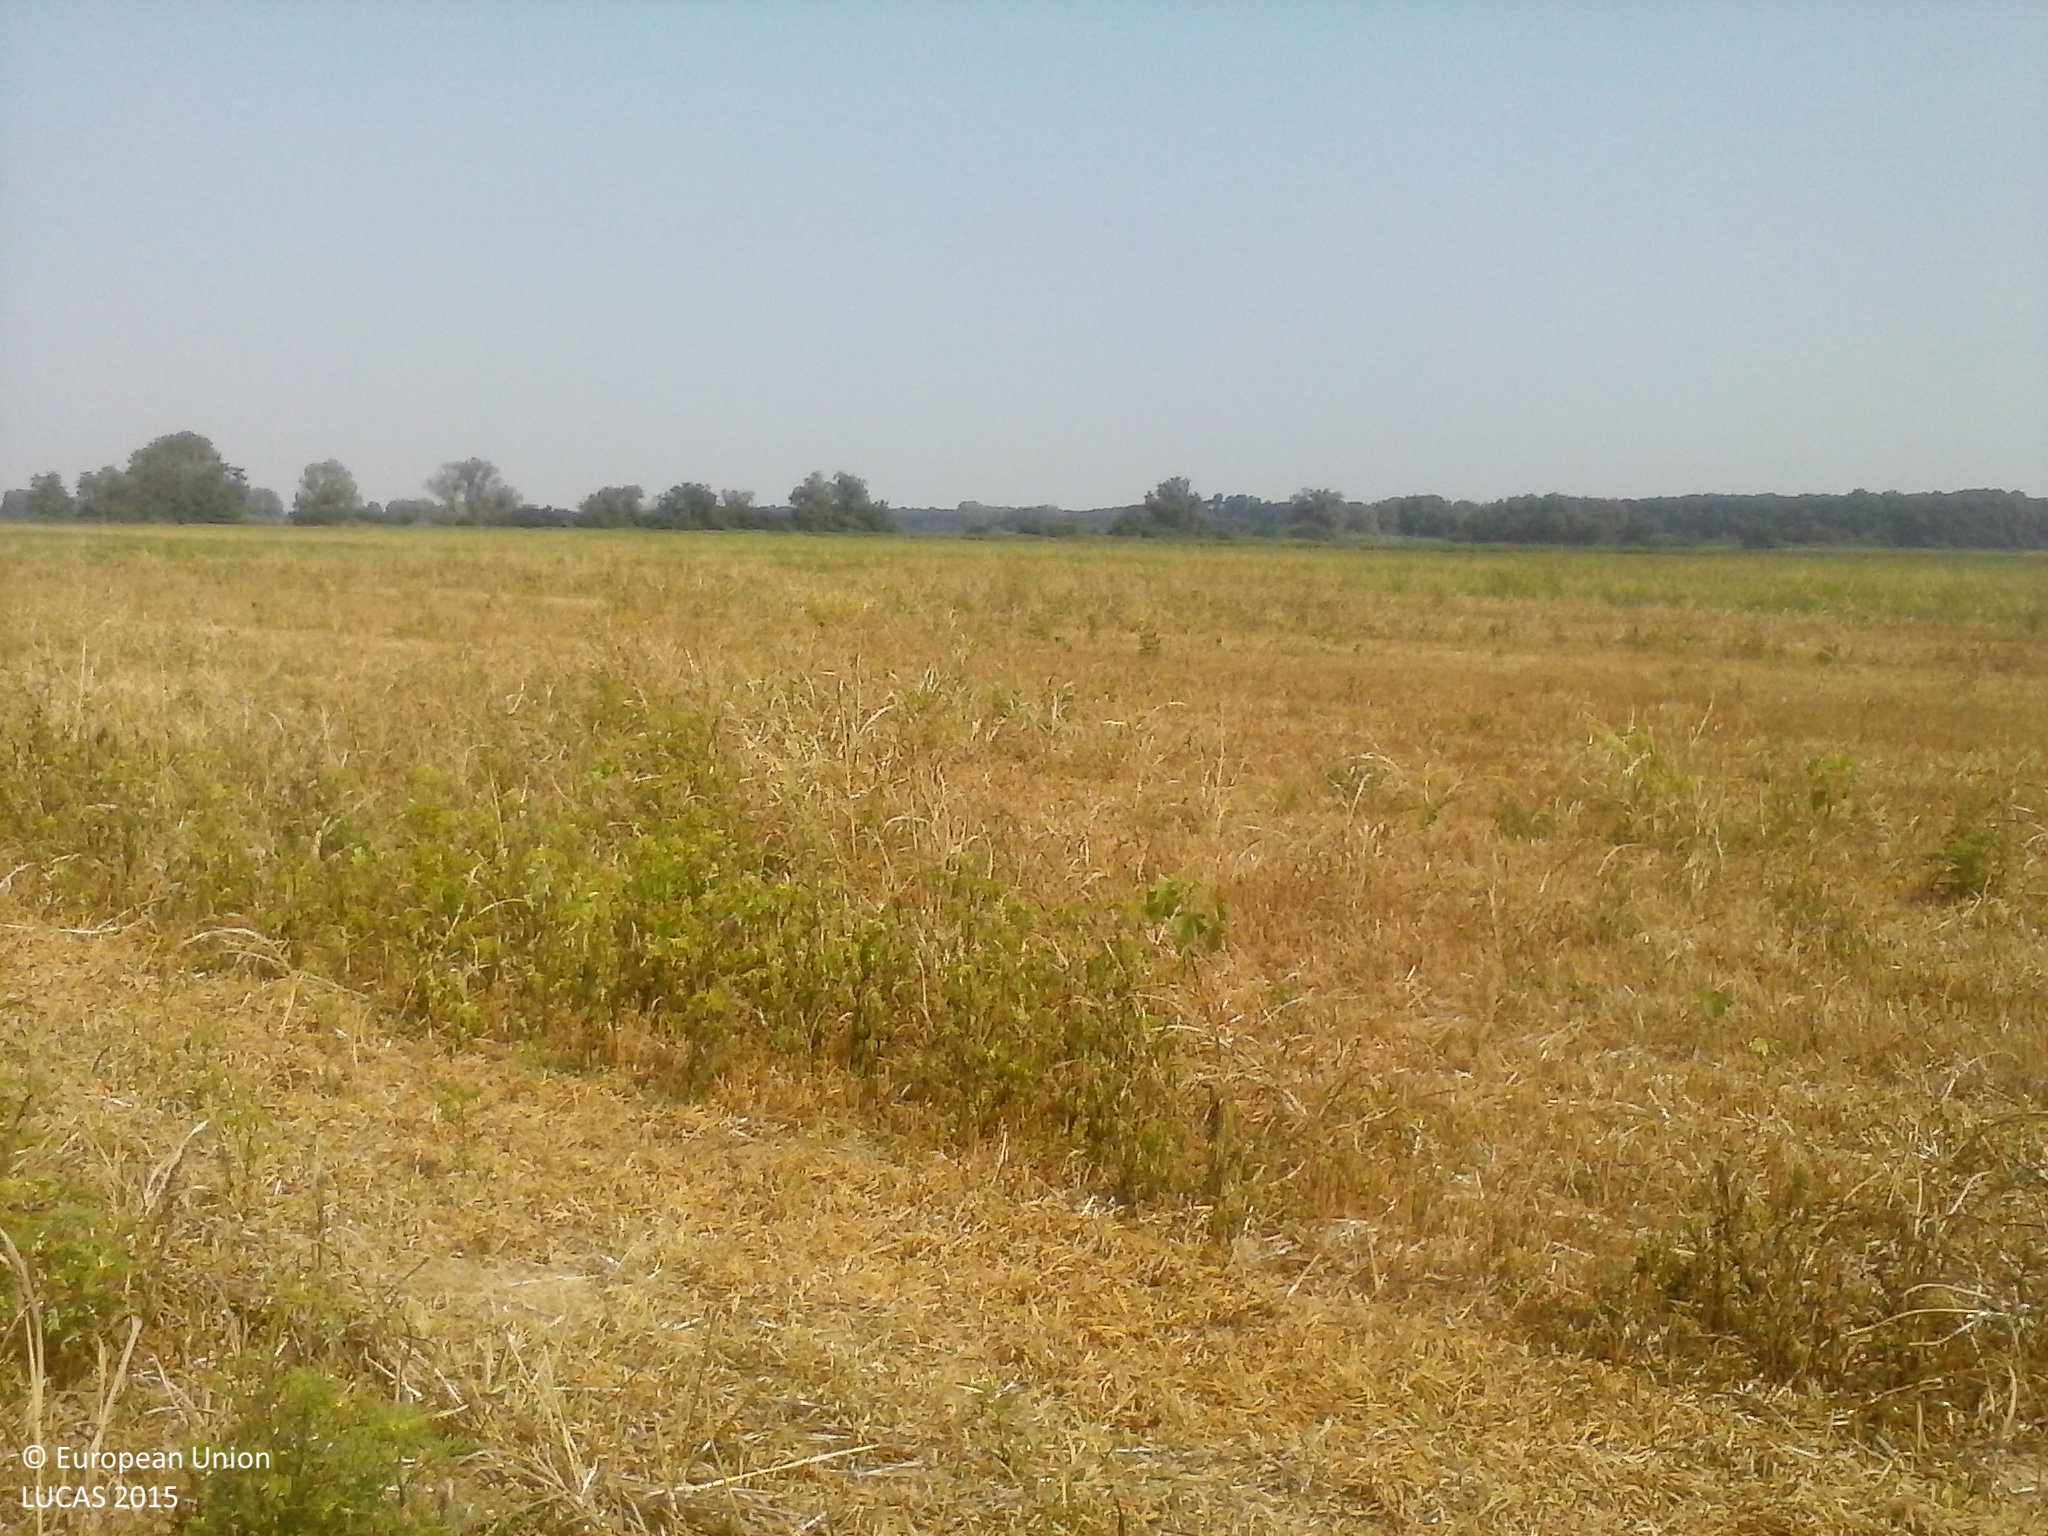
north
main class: Cropland
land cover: Maize
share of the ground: > 75 %
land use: Agriculture (excluding fallow land and kitchen gardens)
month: August
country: HU
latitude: 45.8785
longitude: 17.6439
